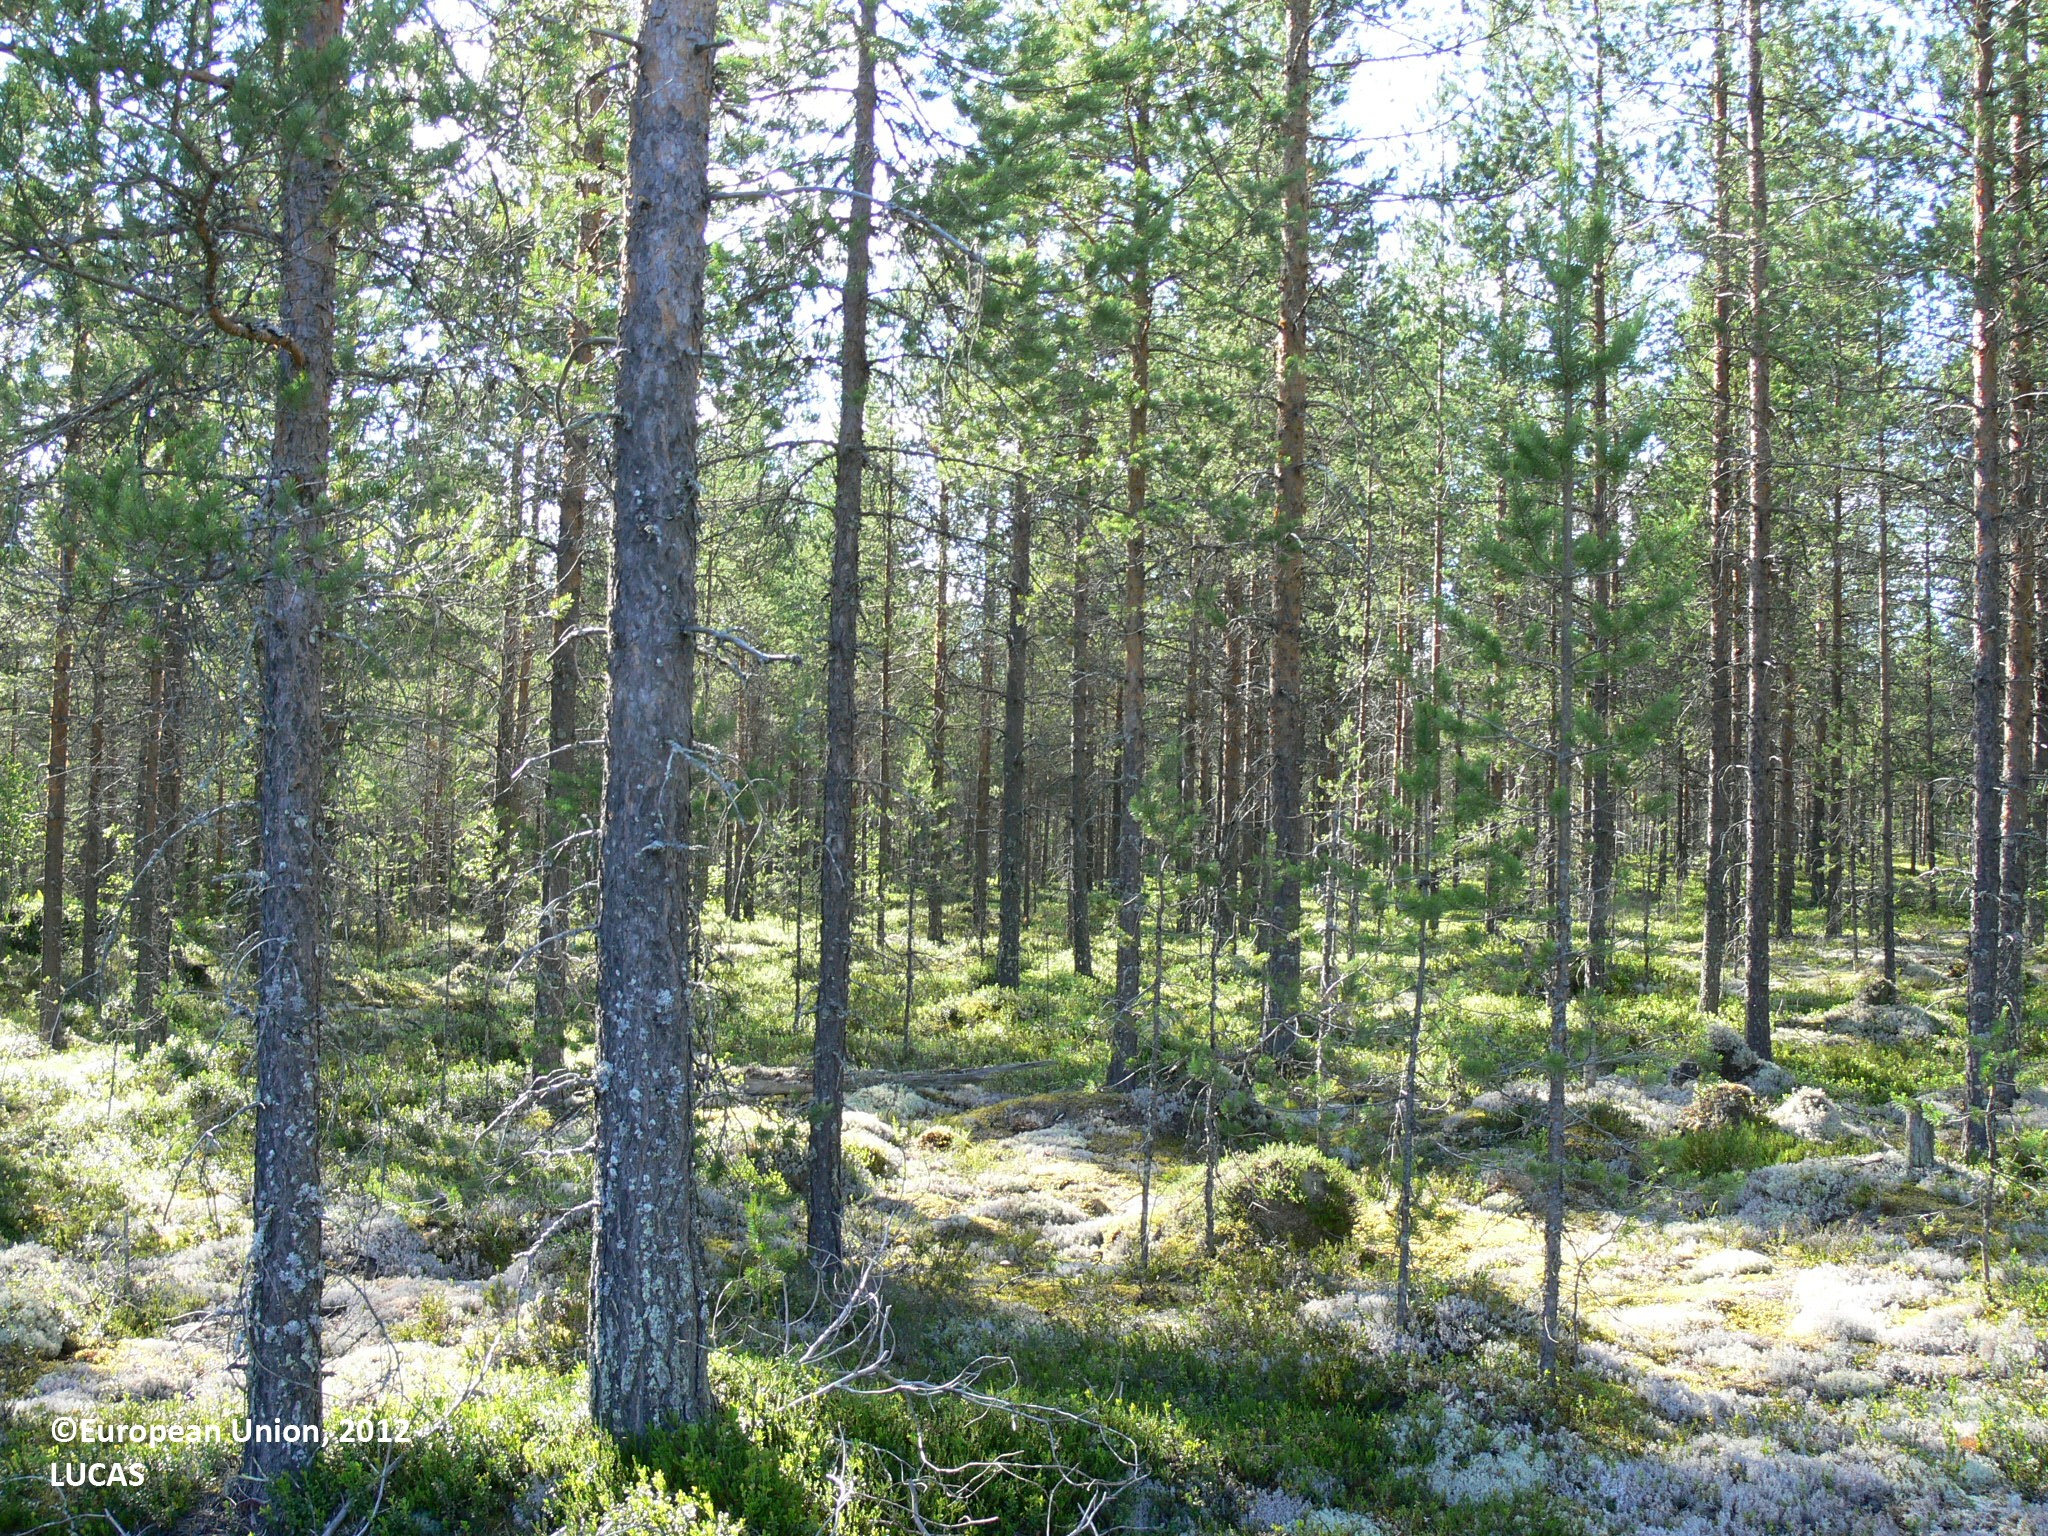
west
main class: Woodland
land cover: Pine dominated coniferous woodland
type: boreal forest
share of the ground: 10 - 25 %
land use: Forestry
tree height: < 5 m
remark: Clear cut
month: July
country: FI
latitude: 63.0968
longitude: 31.1238
